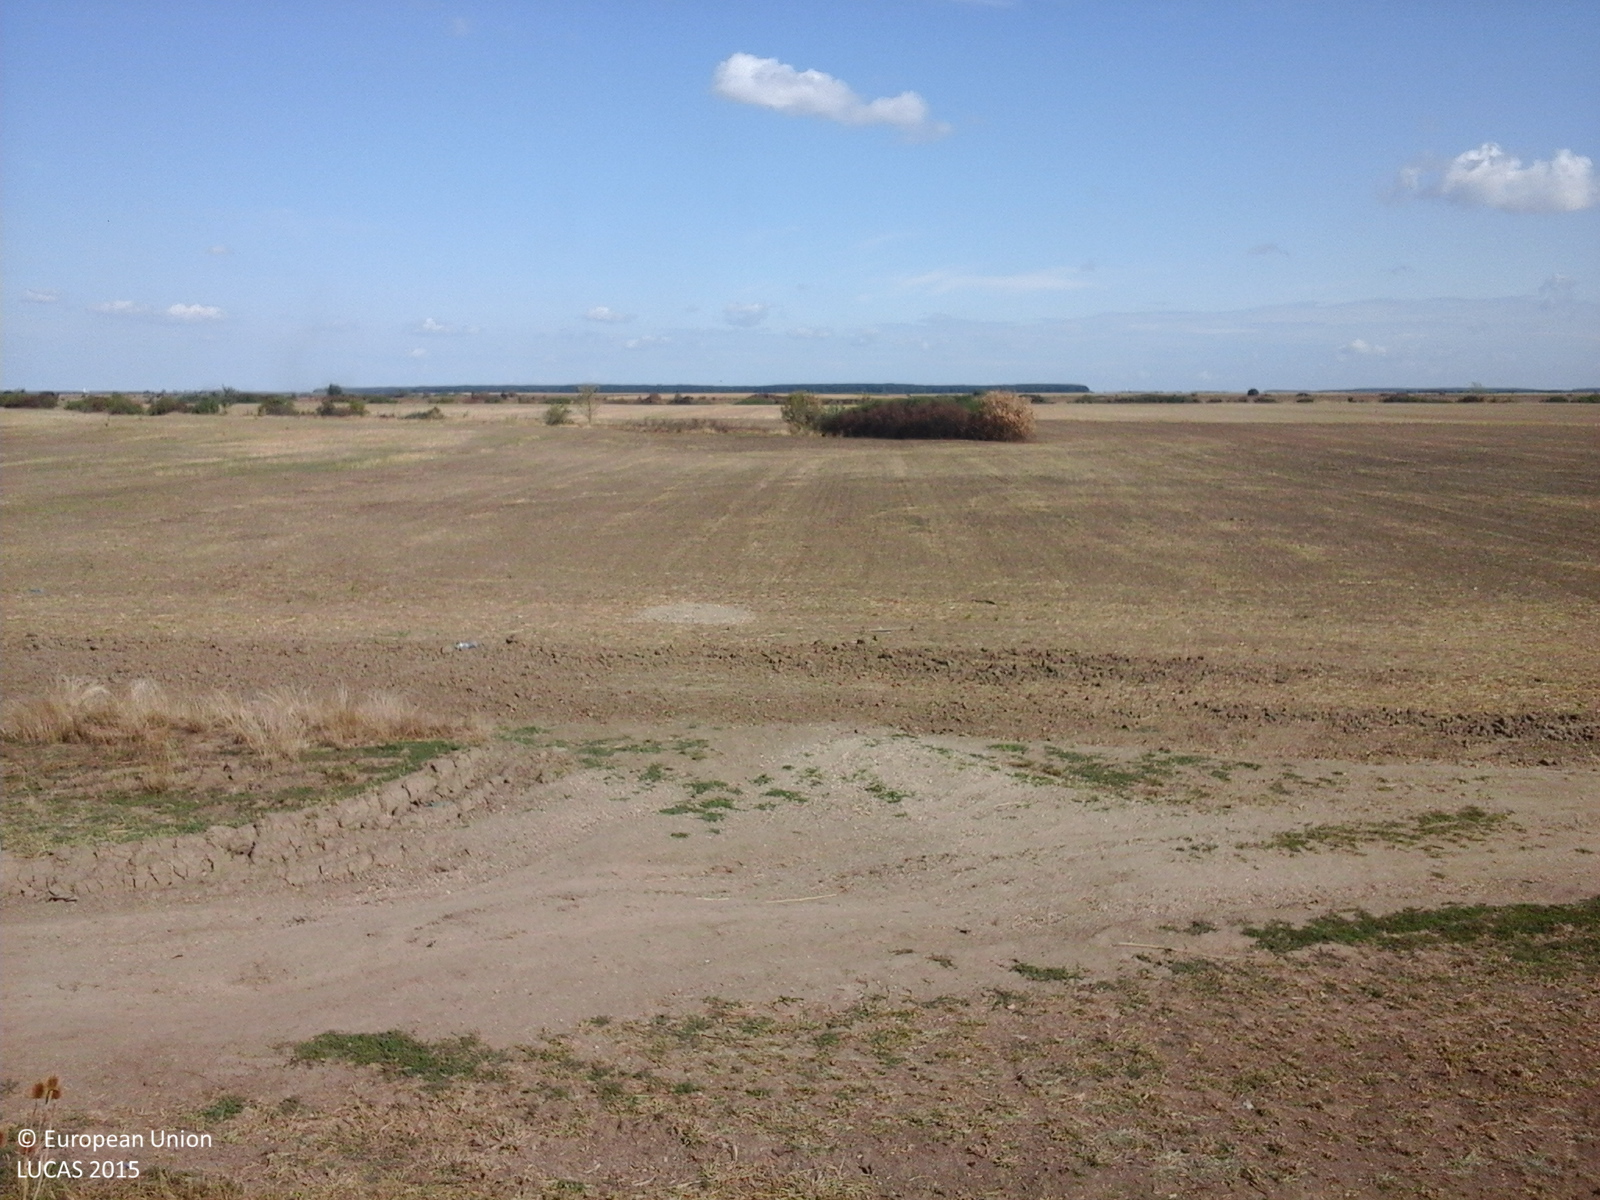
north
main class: Grassland
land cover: Grassland without tree/shrub cover
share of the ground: > 75 %
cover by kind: herbaceous plants 100 %
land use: Agriculture (excluding fallow land and kitchen gardens)
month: September
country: RO
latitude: 47.5876
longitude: 22.7605
